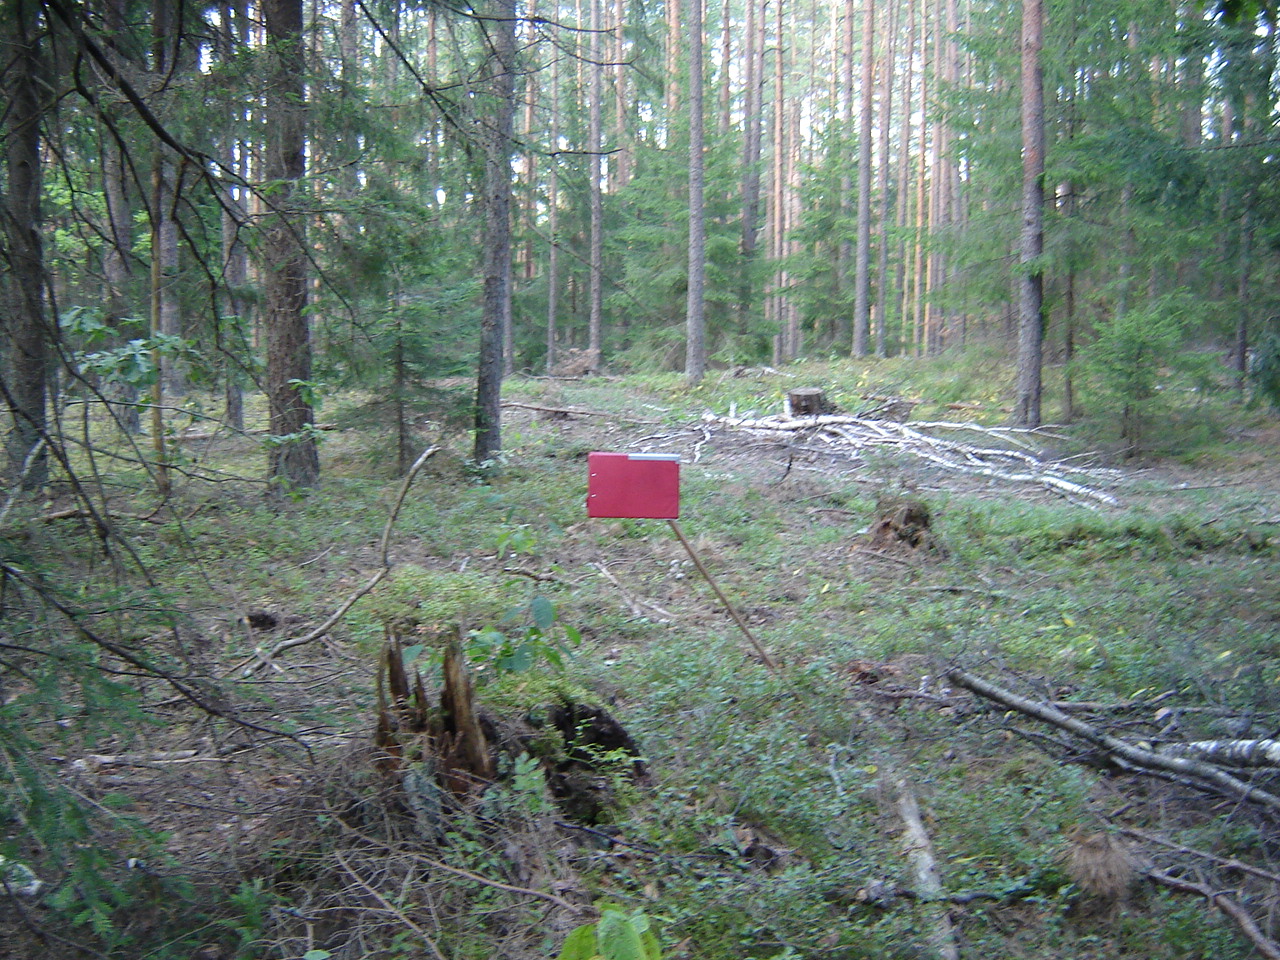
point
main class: Woodland
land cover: Pine dominated coniferous woodland
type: hemiboreal forest and nemoral coniferous forest and mixed broadleaved-coniferous forest
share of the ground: > 75 %
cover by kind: coniferous forest trees 80 %, shrubs 10 %, lichens and mosses 10 %
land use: Forestry
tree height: > 5 m
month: August
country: LT
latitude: 54.7835
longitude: 24.8672
